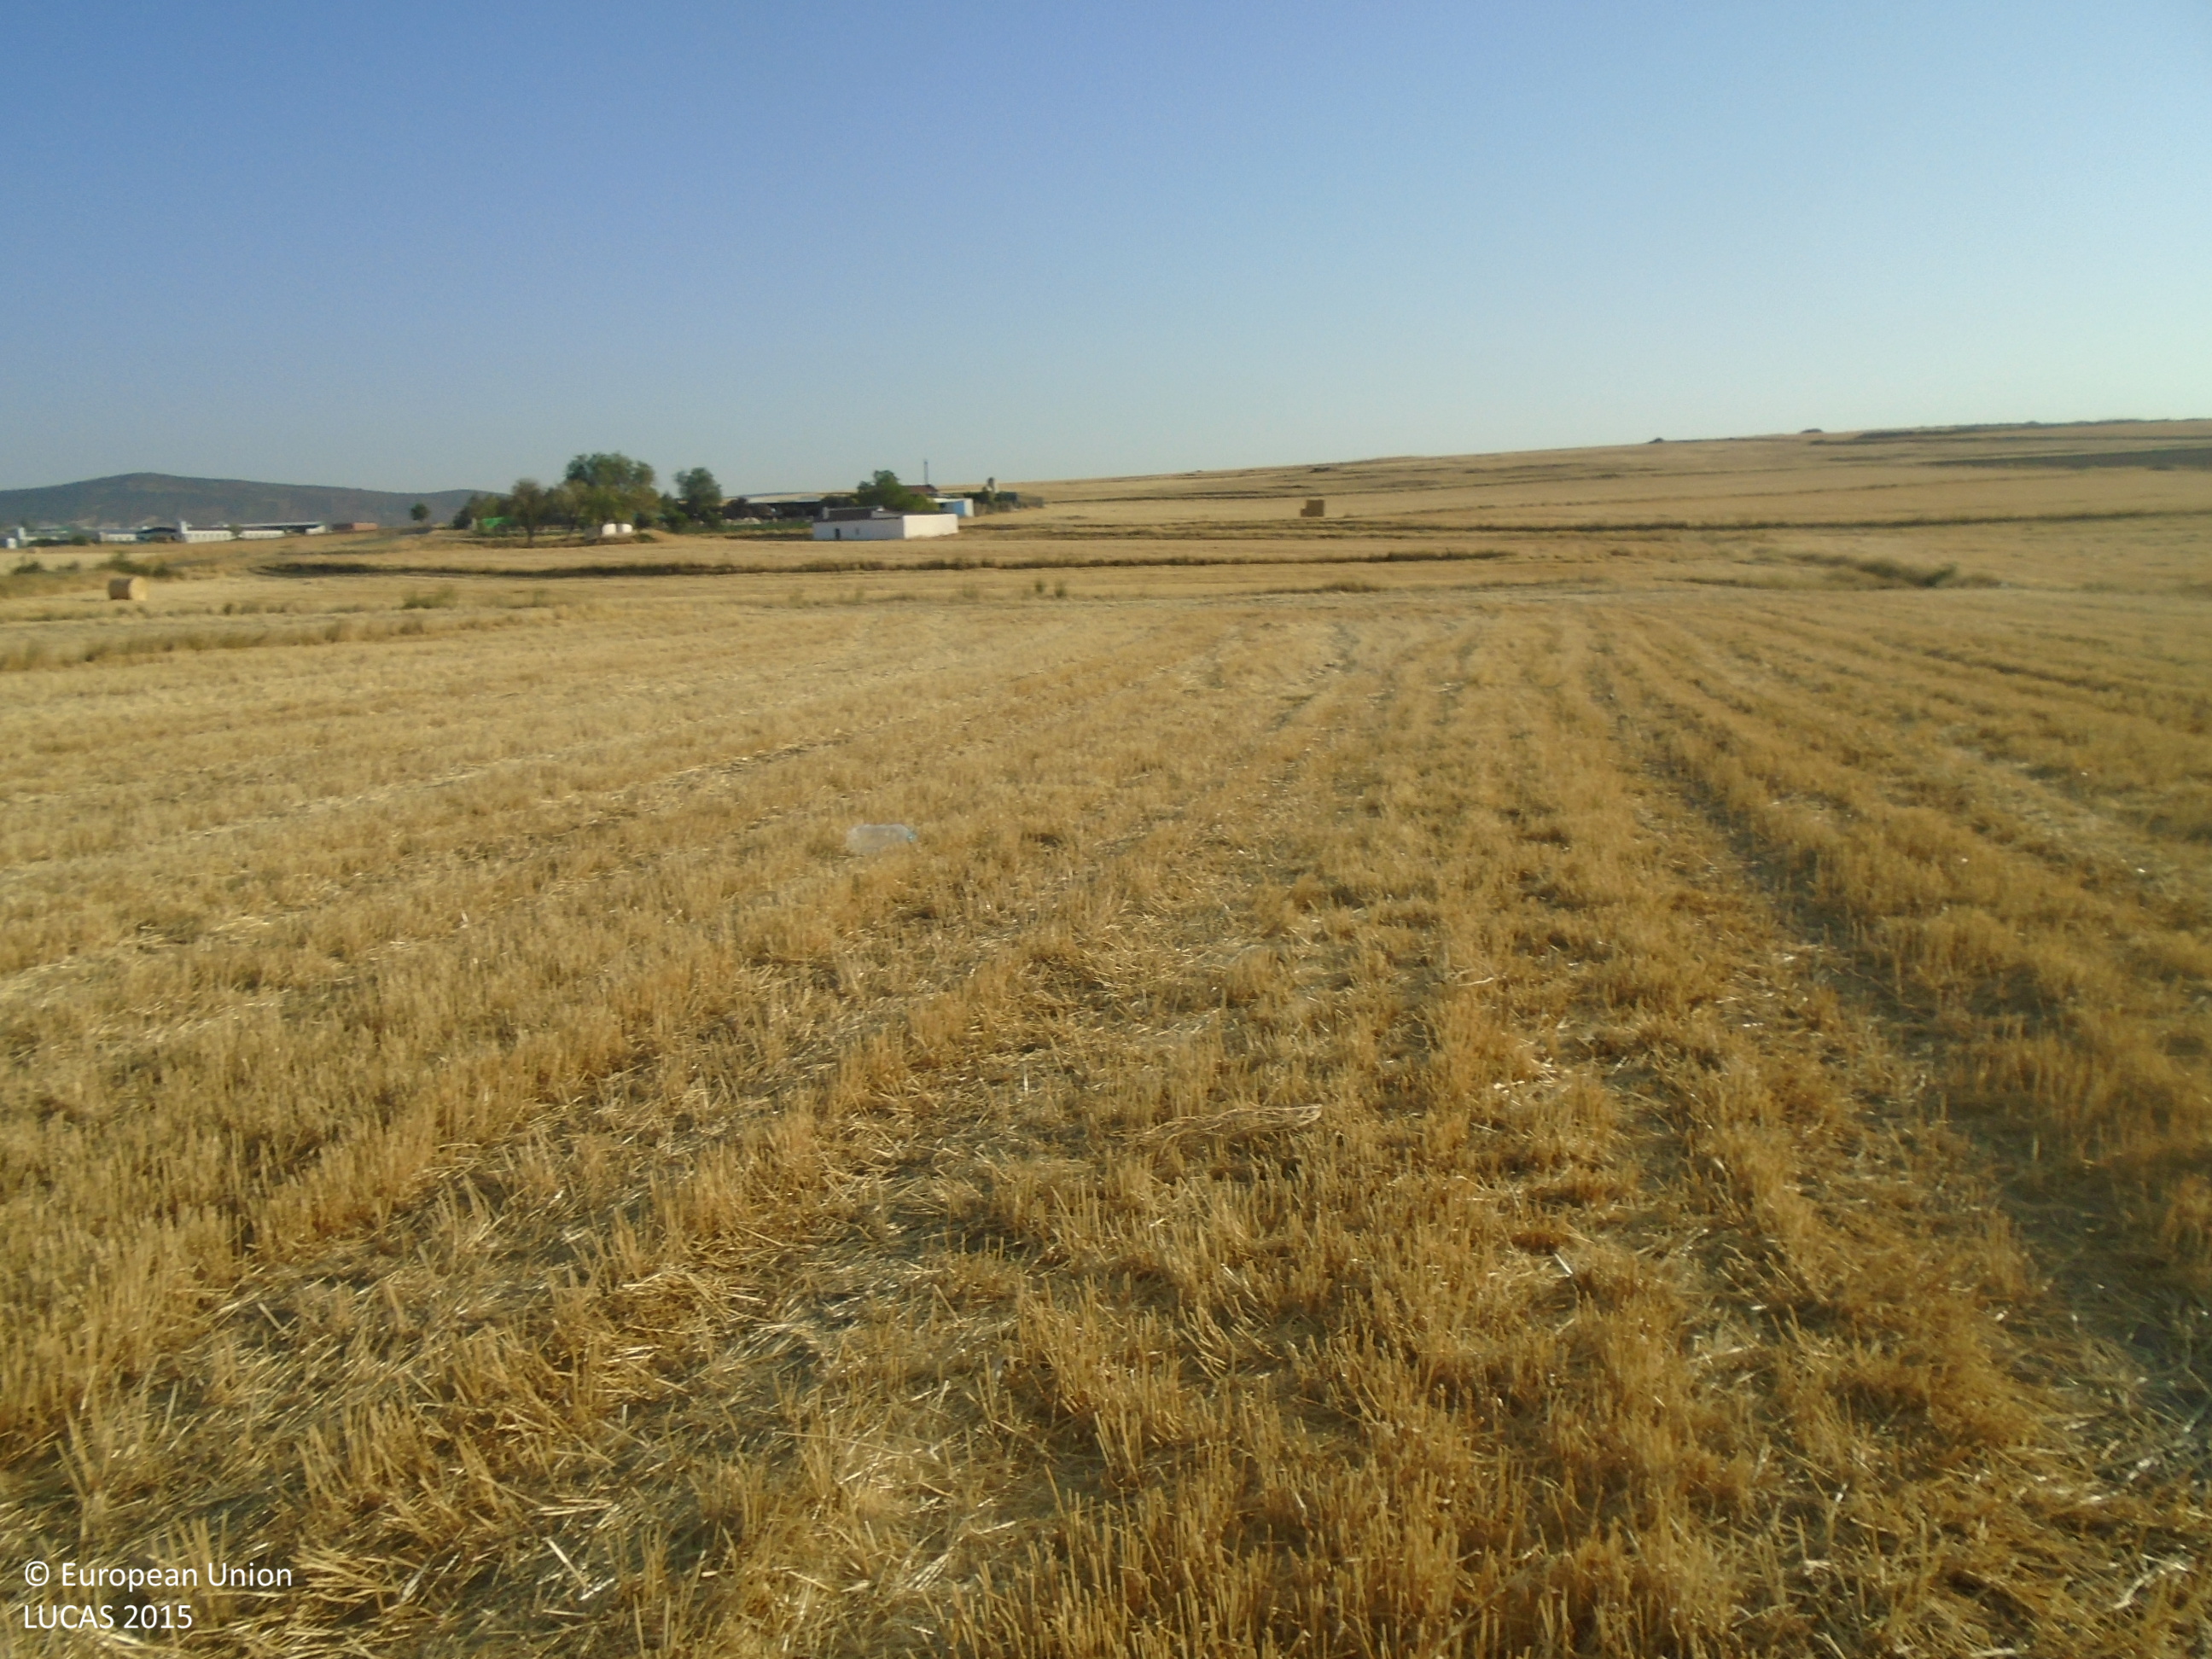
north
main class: Cropland
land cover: Barley
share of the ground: > 75 %
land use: Agriculture (excluding fallow land and kitchen gardens)
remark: Harvested field
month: July
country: ES
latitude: 39.3910
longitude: -3.7129
